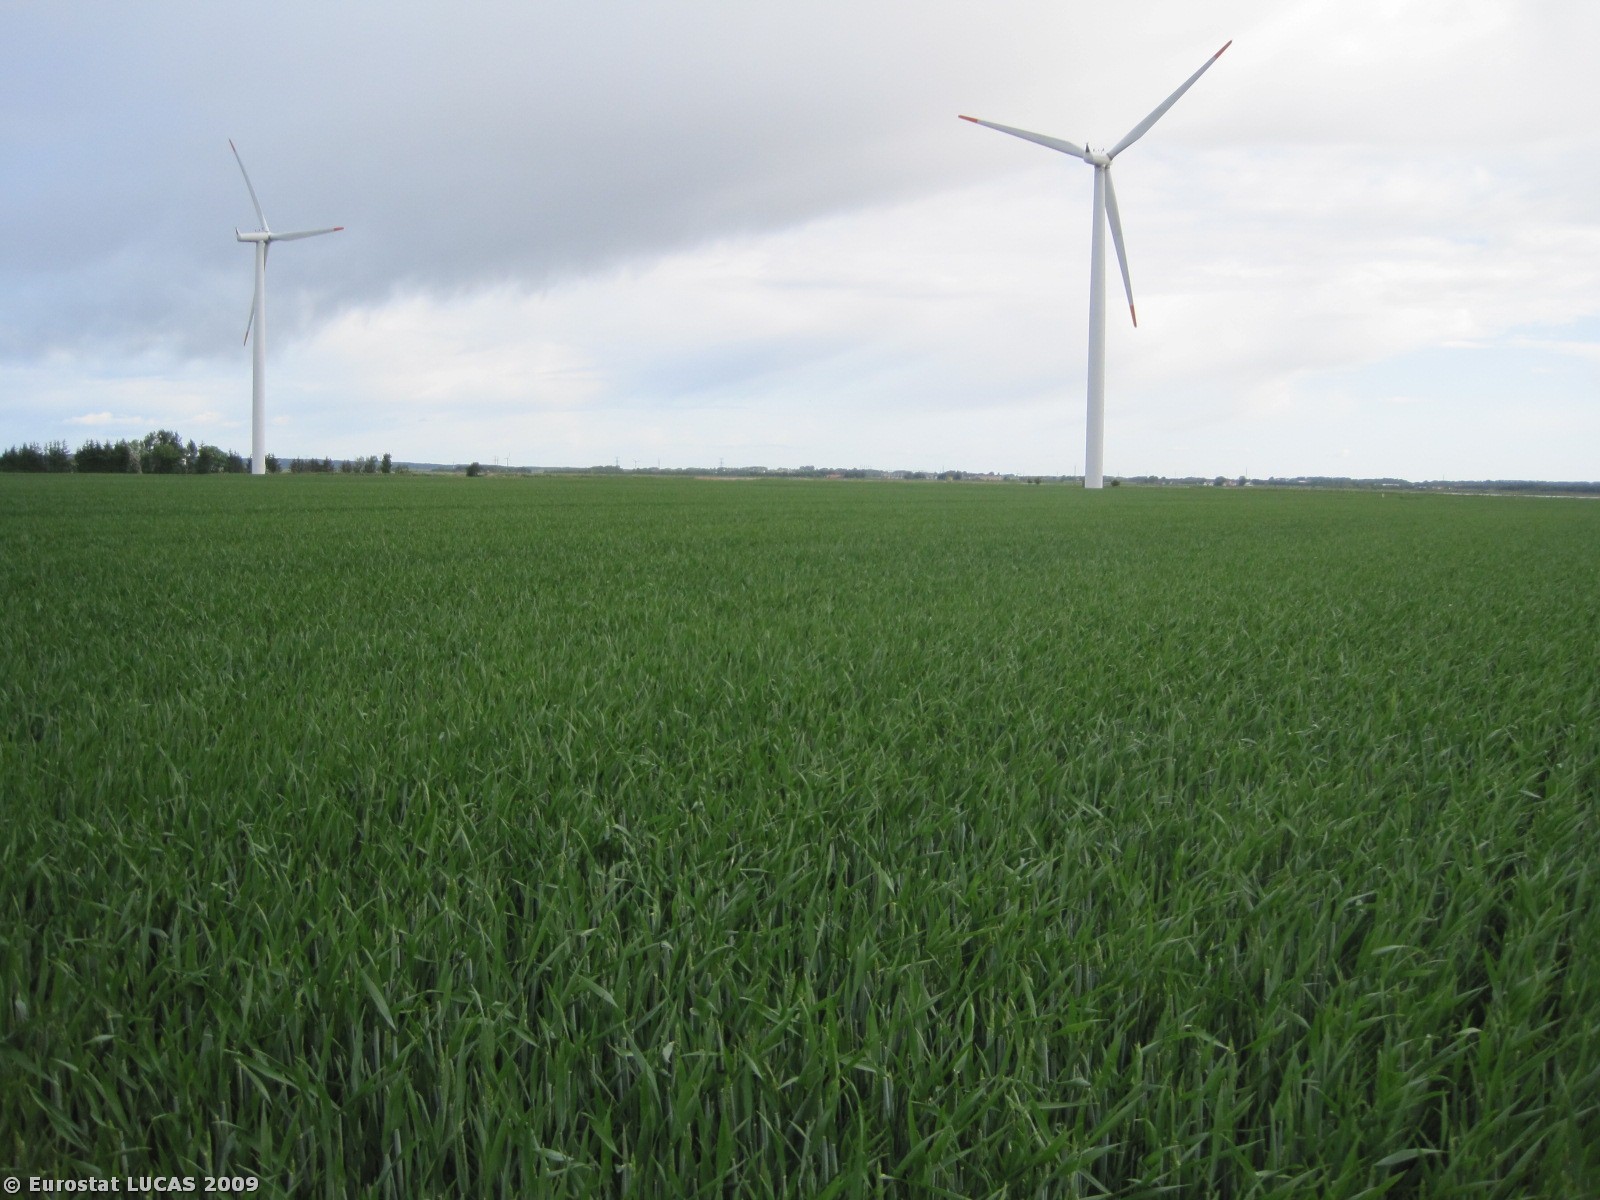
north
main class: Cropland
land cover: Common wheat
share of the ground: > 75 %
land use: Agriculture (excluding fallow land and kitchen gardens)
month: June
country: DK
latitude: 57.0326
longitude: 10.0823
